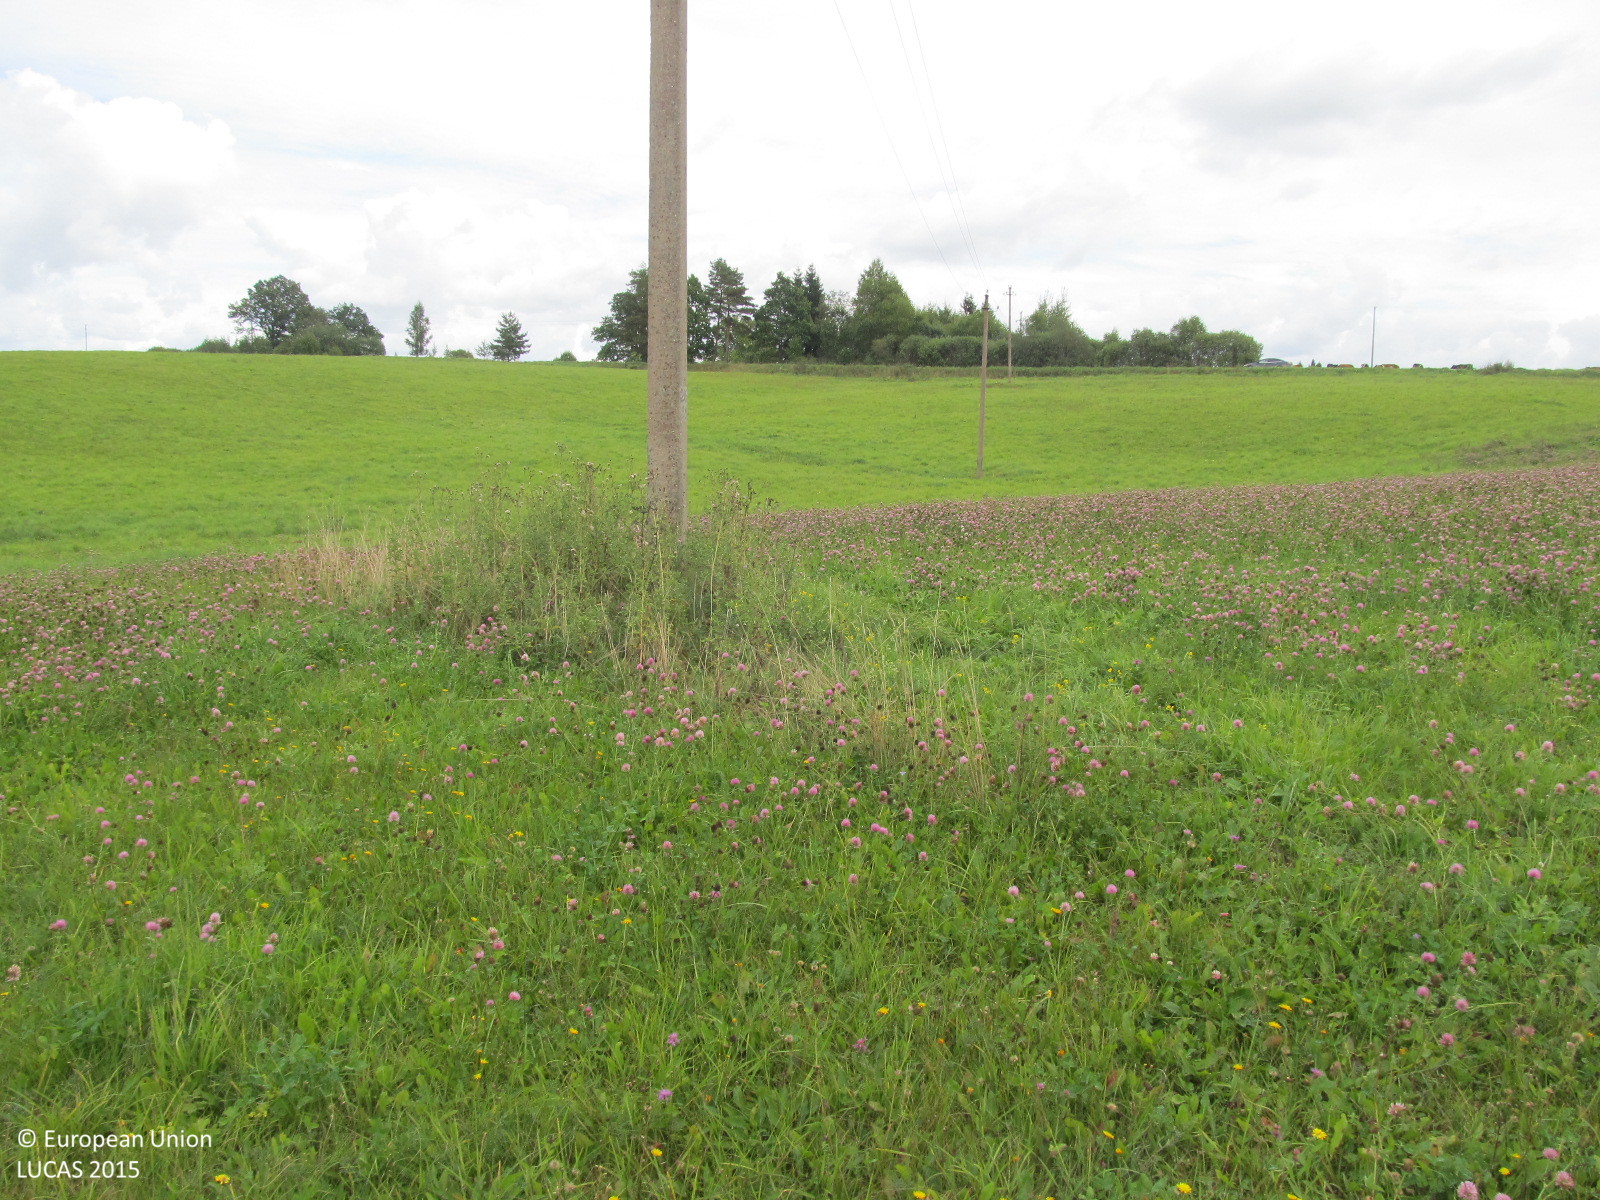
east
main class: Grassland
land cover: Grassland without tree/shrub cover
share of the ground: > 75 %
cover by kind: herbaceous plants 100 %
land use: Agriculture (excluding fallow land and kitchen gardens)
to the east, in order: Grassland without tree/shrub cover; Paved roads, cycling and walking lanes; Grassland without tree/shrub cover; Fences; Grassland without tree/shrub cover; Electric lines; Grassland without tree/shrub cover; Fences; Grassland without tree/shrub cover
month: September
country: LT
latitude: 55.6545
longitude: 22.6018
